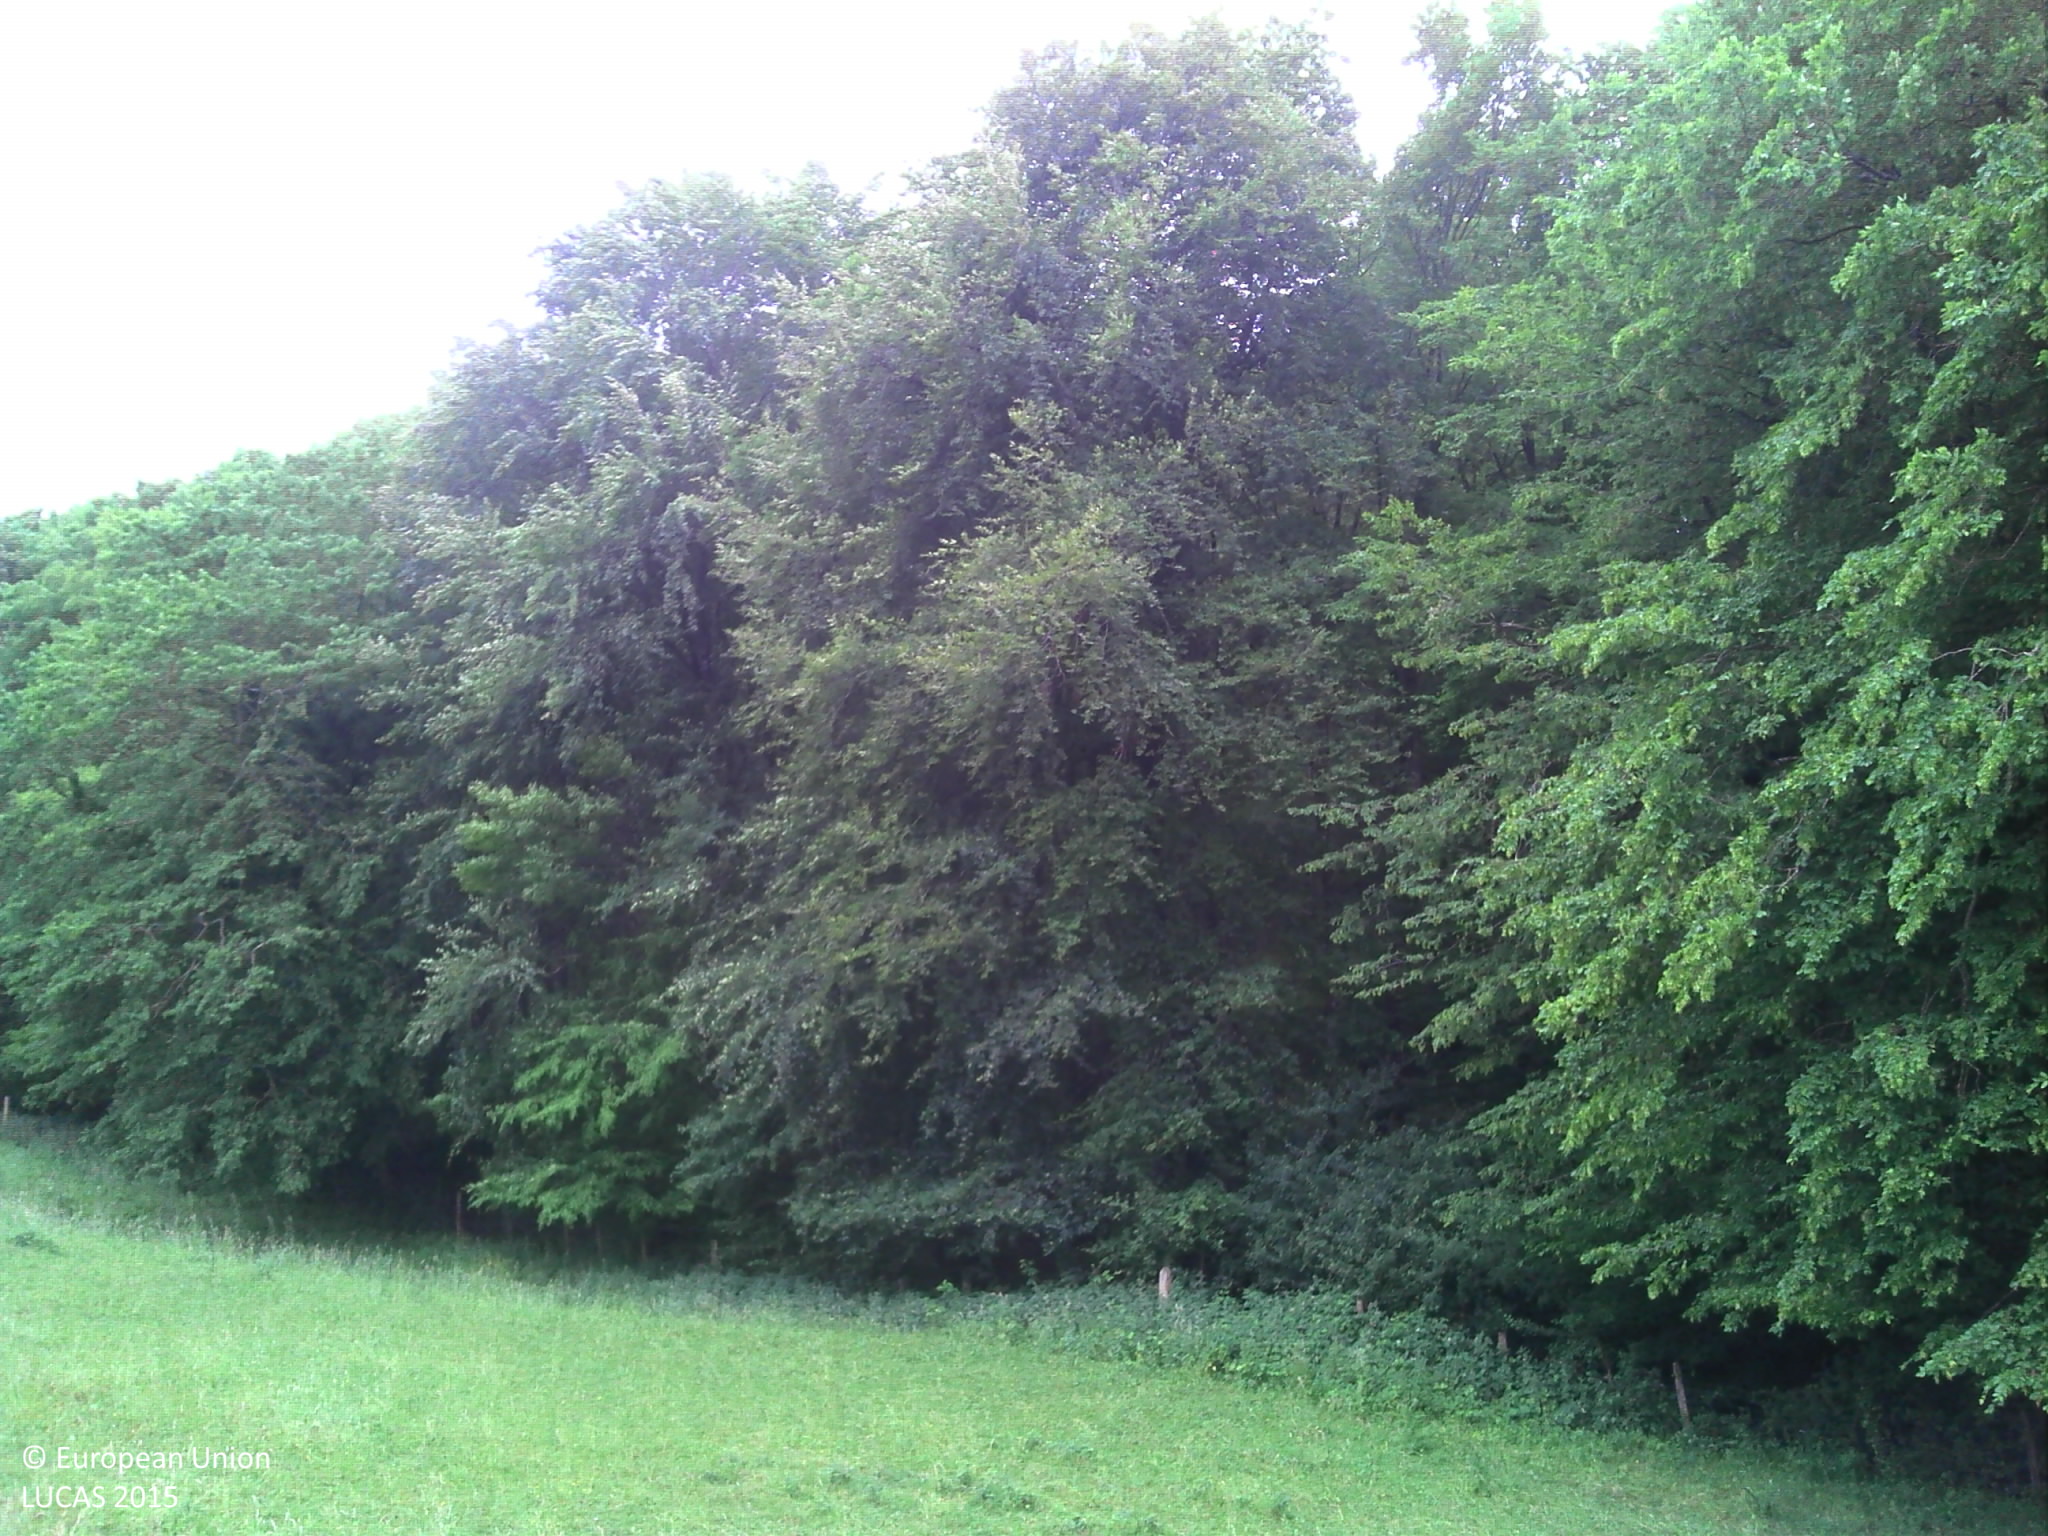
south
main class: Grassland
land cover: Grassland without tree/shrub cover
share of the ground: > 75 %
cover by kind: herbaceous plants 100 %
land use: Agriculture (excluding fallow land and kitchen gardens)
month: June
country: FR
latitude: 46.5303
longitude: 4.7737
